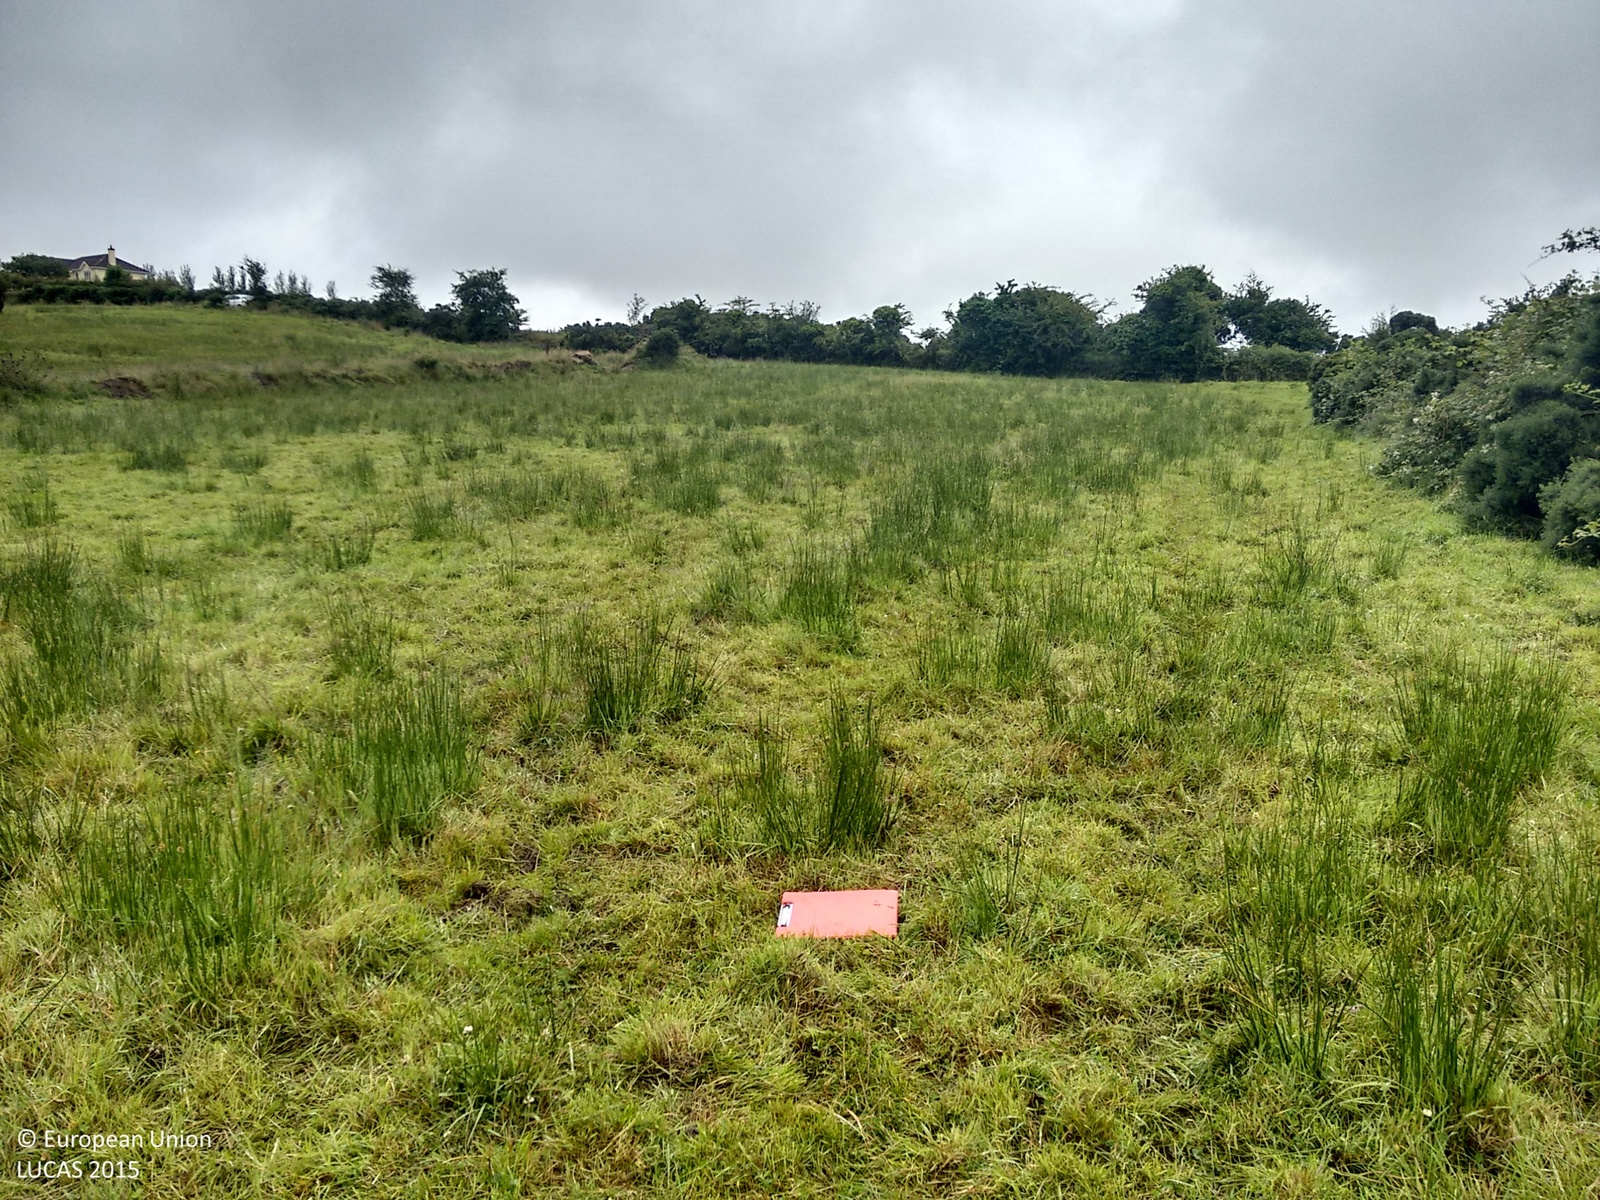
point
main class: Grassland
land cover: Grassland without tree/shrub cover
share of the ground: > 75 %
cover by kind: herbaceous plants 100 %
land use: Agriculture (excluding fallow land and kitchen gardens)
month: July
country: IE
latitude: 53.6630
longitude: -7.7358
